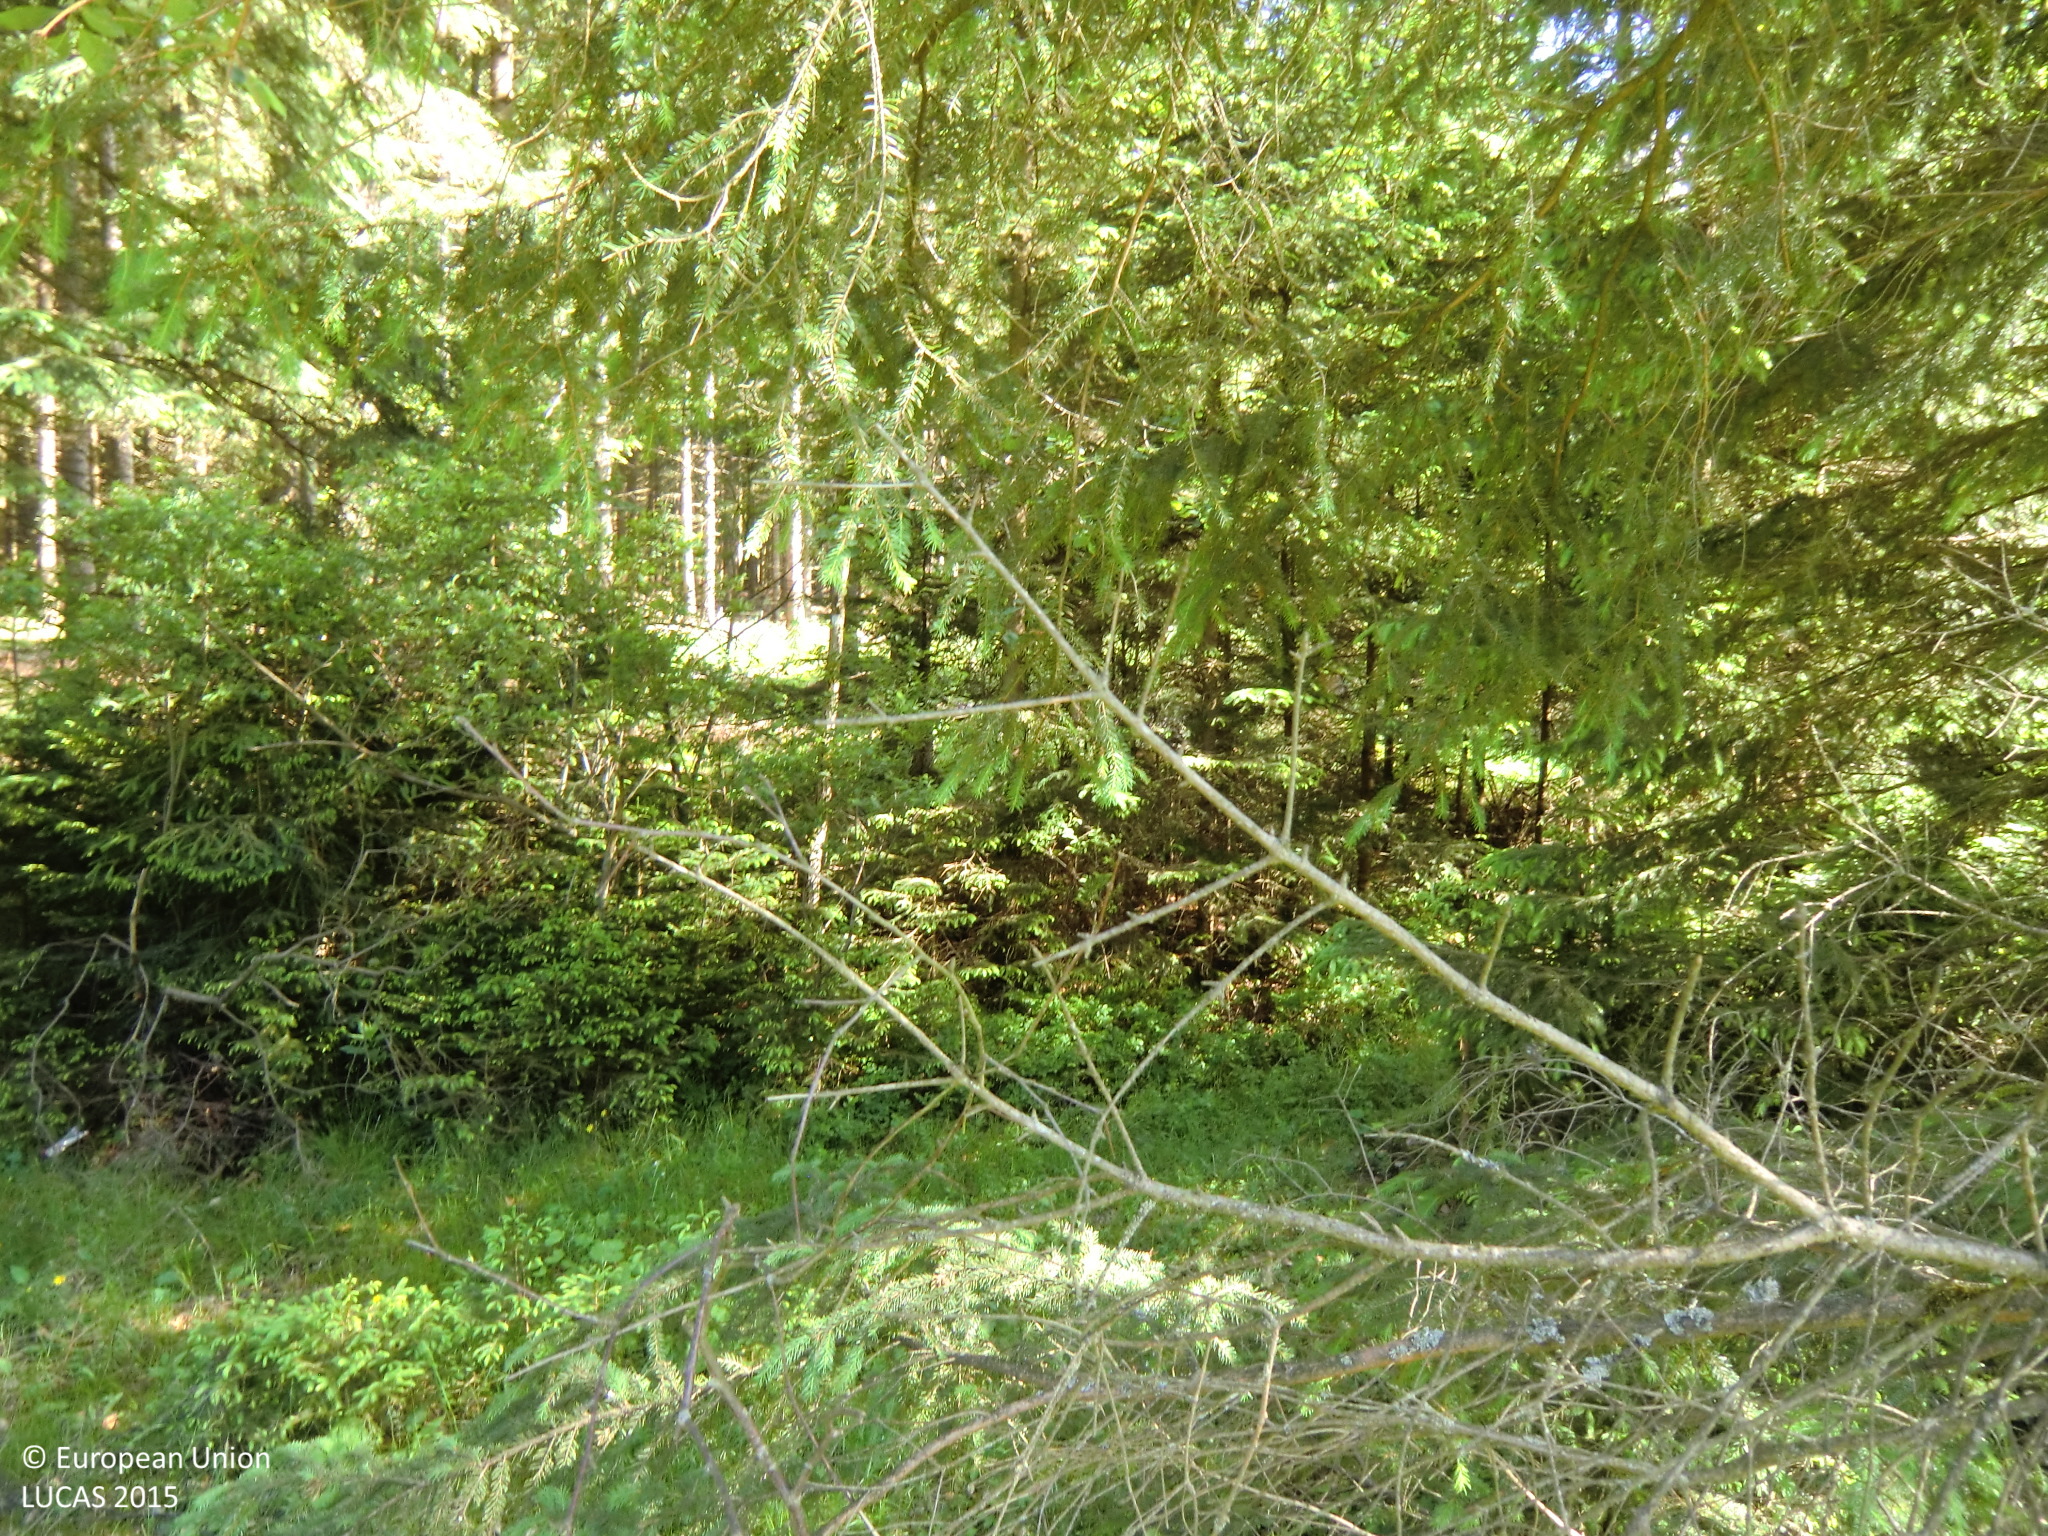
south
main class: Woodland
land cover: Spruce dominated coniferous woodland
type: hemiboreal forest and nemoral coniferous forest and mixed broadleaved-coniferous forest
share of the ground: > 75 %
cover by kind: coniferous forest trees 80 %, herbaceous plants 20 %
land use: Forestry
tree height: > 5 m
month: June
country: AT
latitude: 48.5558
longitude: 14.7025
